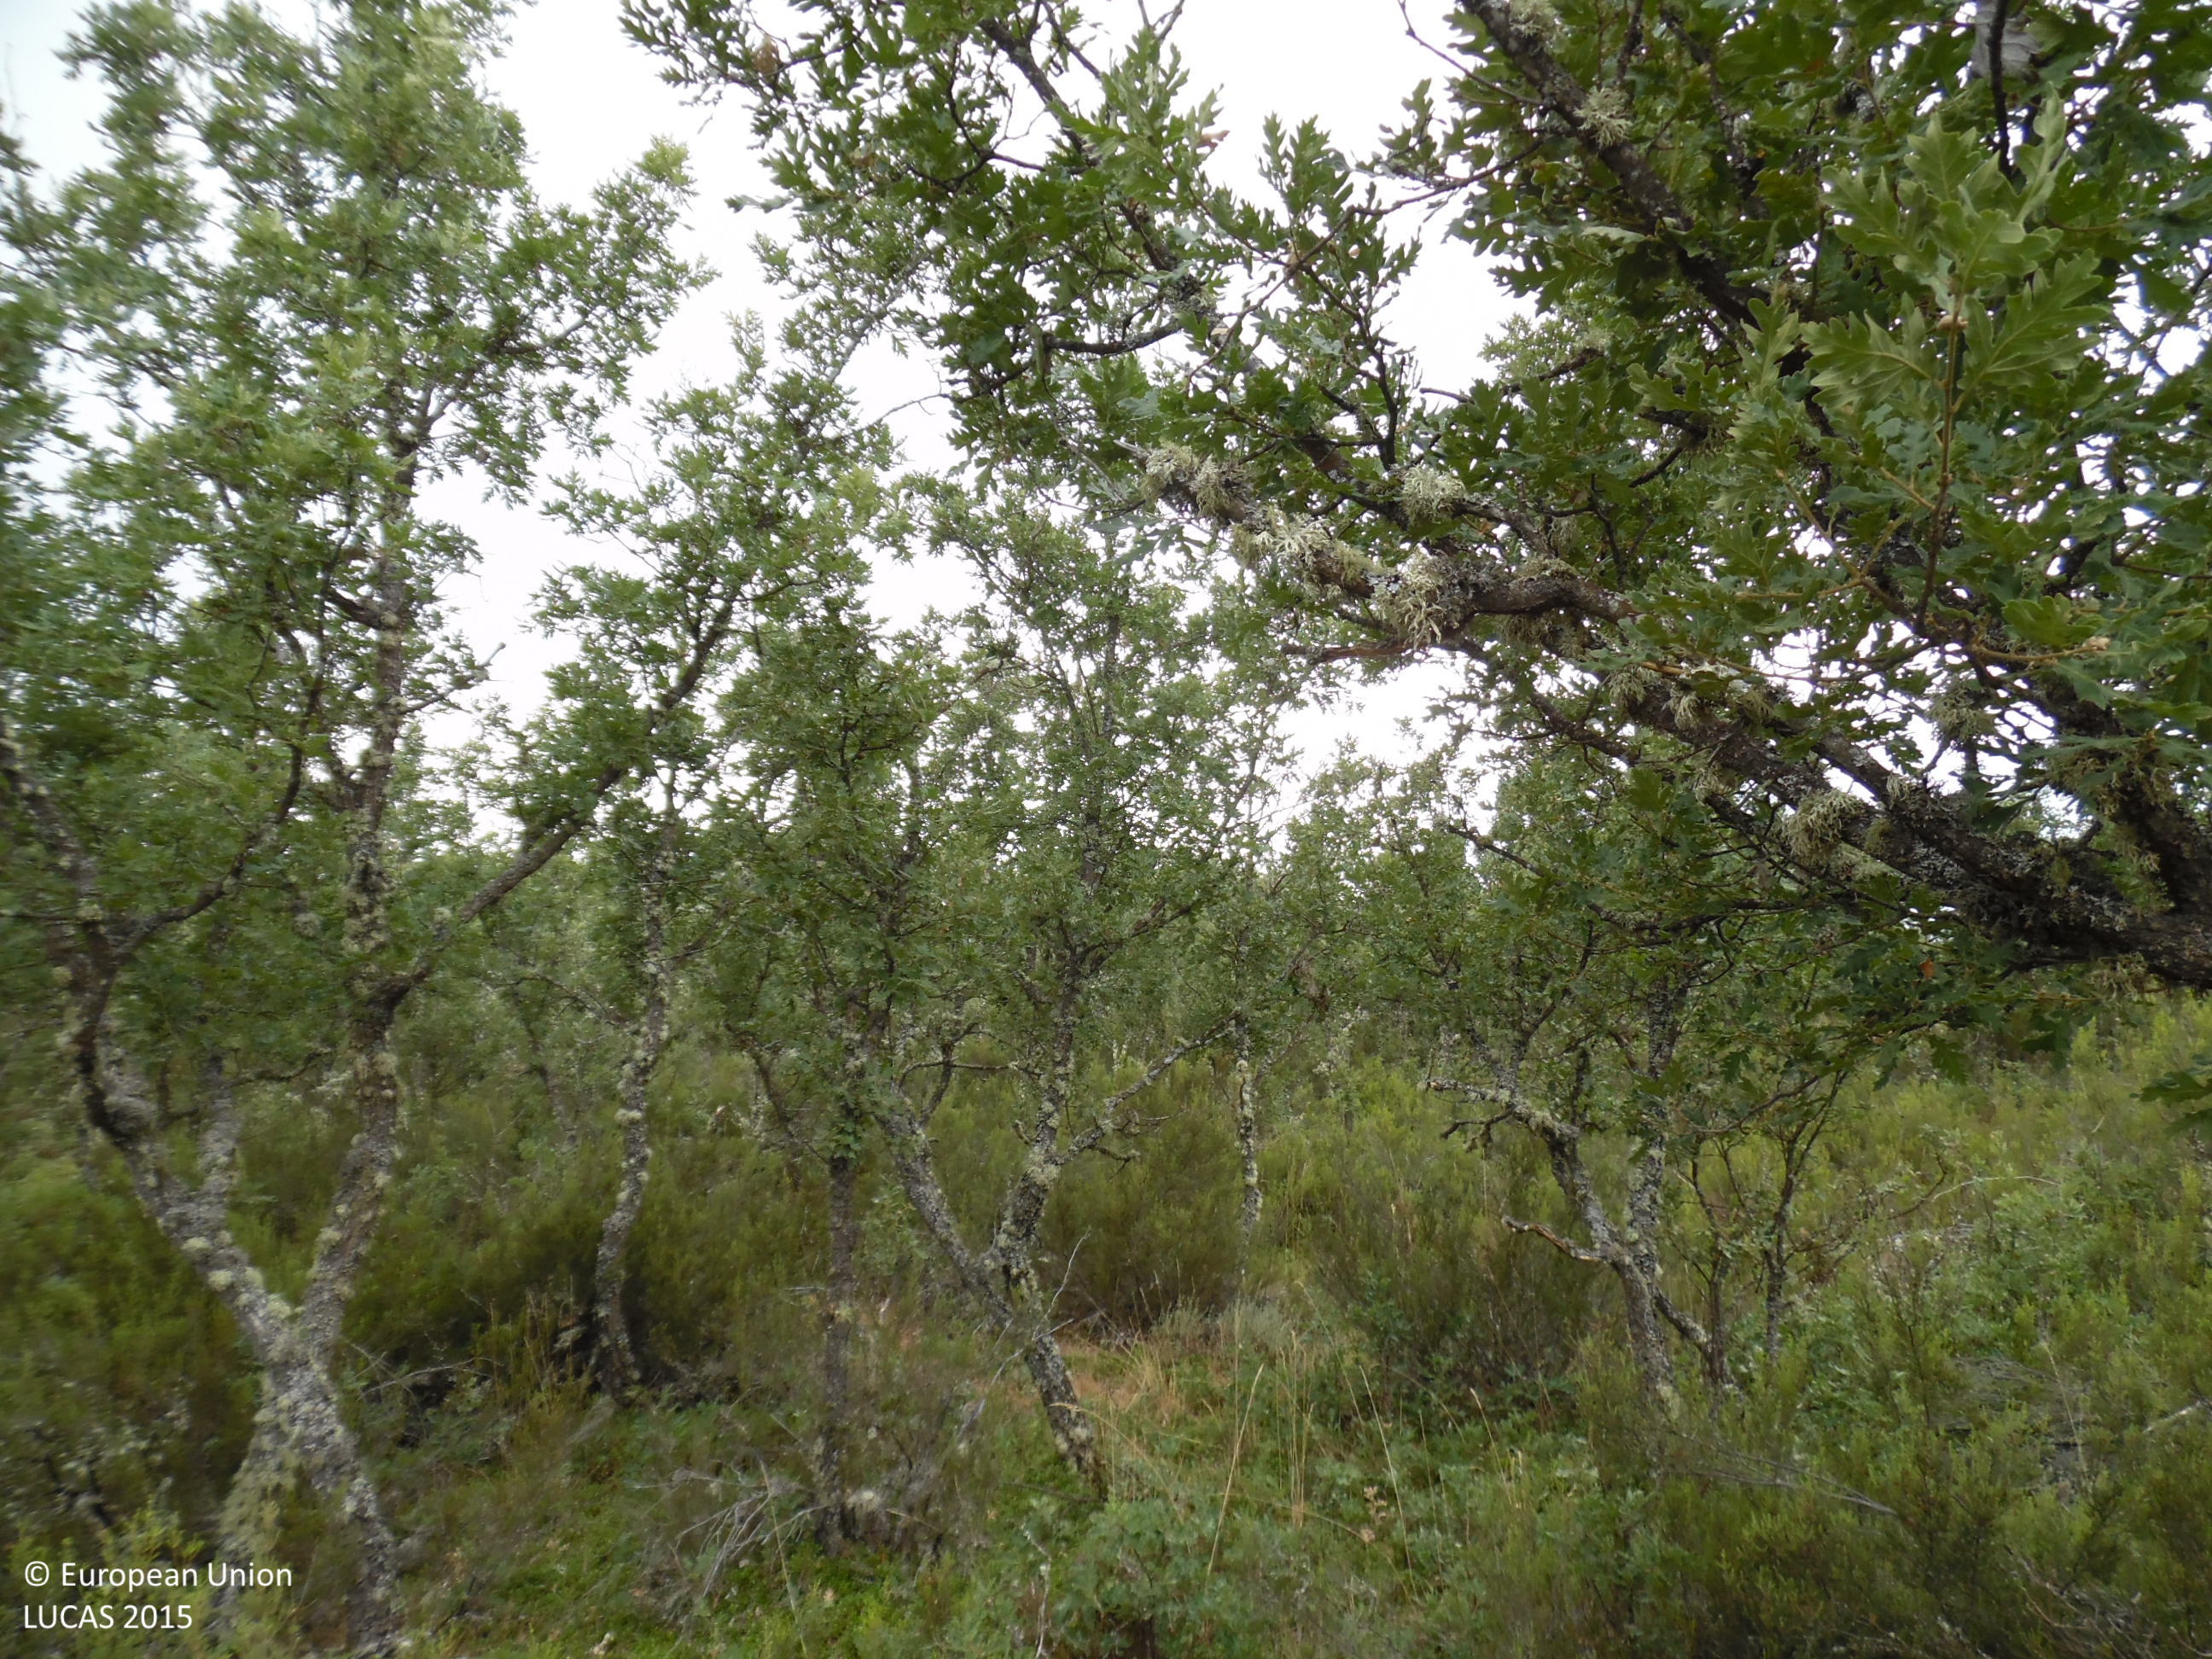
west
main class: Woodland
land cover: Broadleaved woodland
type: broadleaved evergreen forest
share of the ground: > 75 %
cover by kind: broadleaved forest trees 90 %, shrubs 10 %
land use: Forestry
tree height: > 5 m
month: July
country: ES
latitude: 42.6256
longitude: -5.7447
